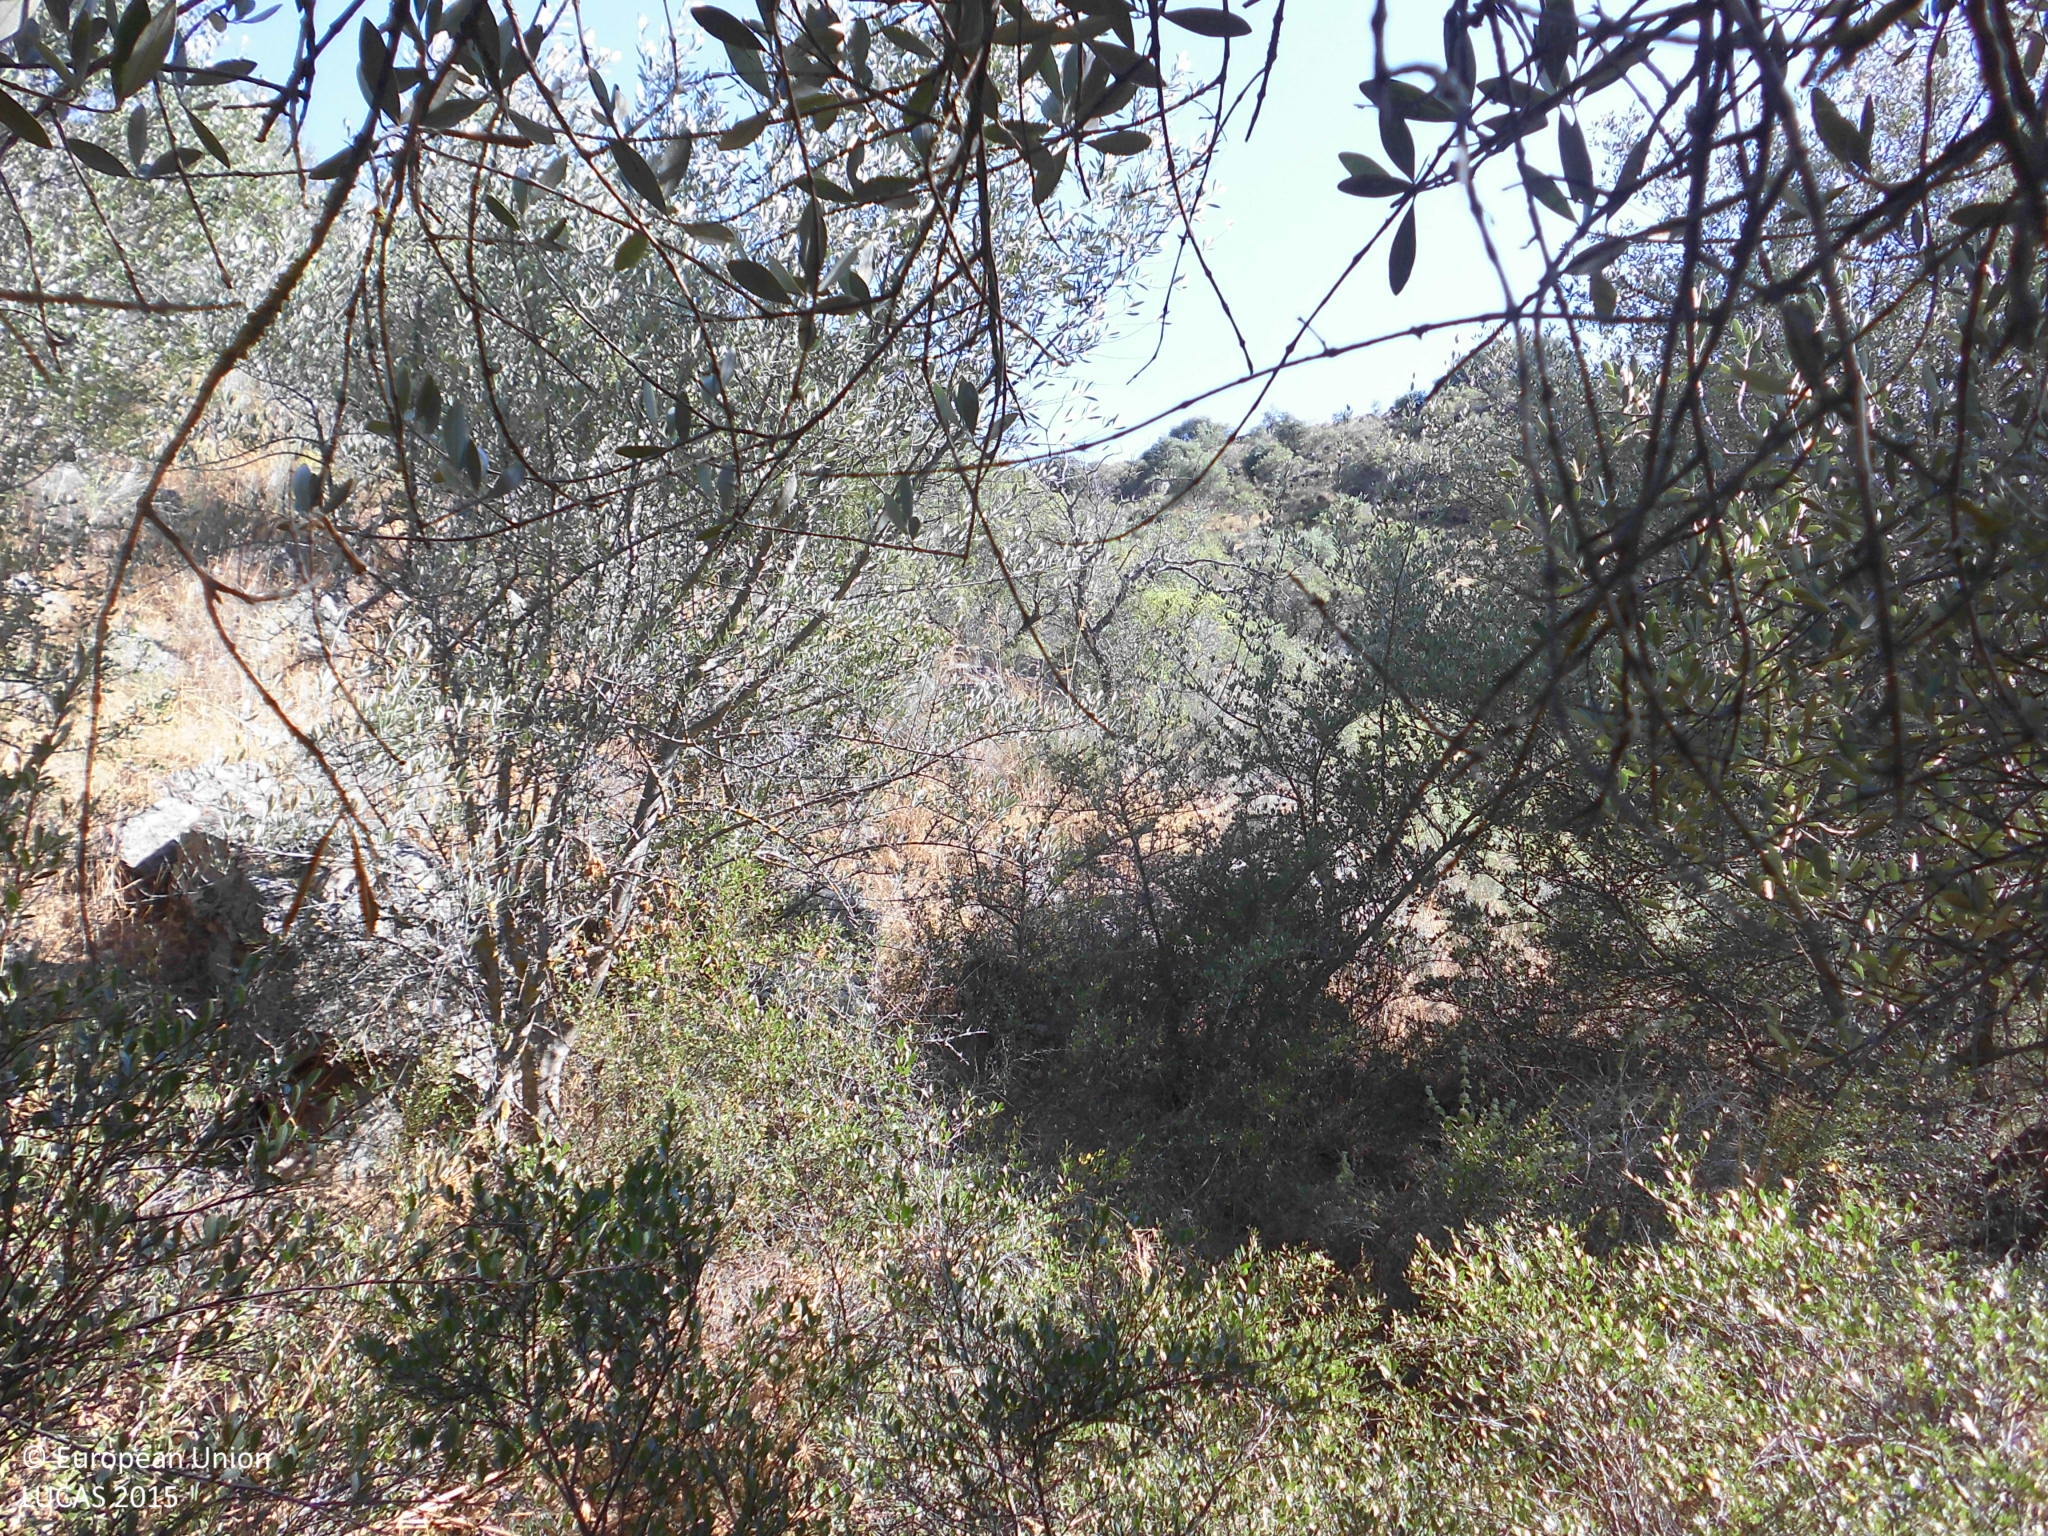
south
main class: Woodland
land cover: Broadleaved woodland
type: thermophilous deciduous forest
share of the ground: 25 - 50 %
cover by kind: broadleaved forest trees 50 %, shrubs 40 %, herbaceous plants 10 %
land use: Semi-natural and natural areas not in use
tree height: > 5 m
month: June
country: ES
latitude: 39.7347
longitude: -6.4444
